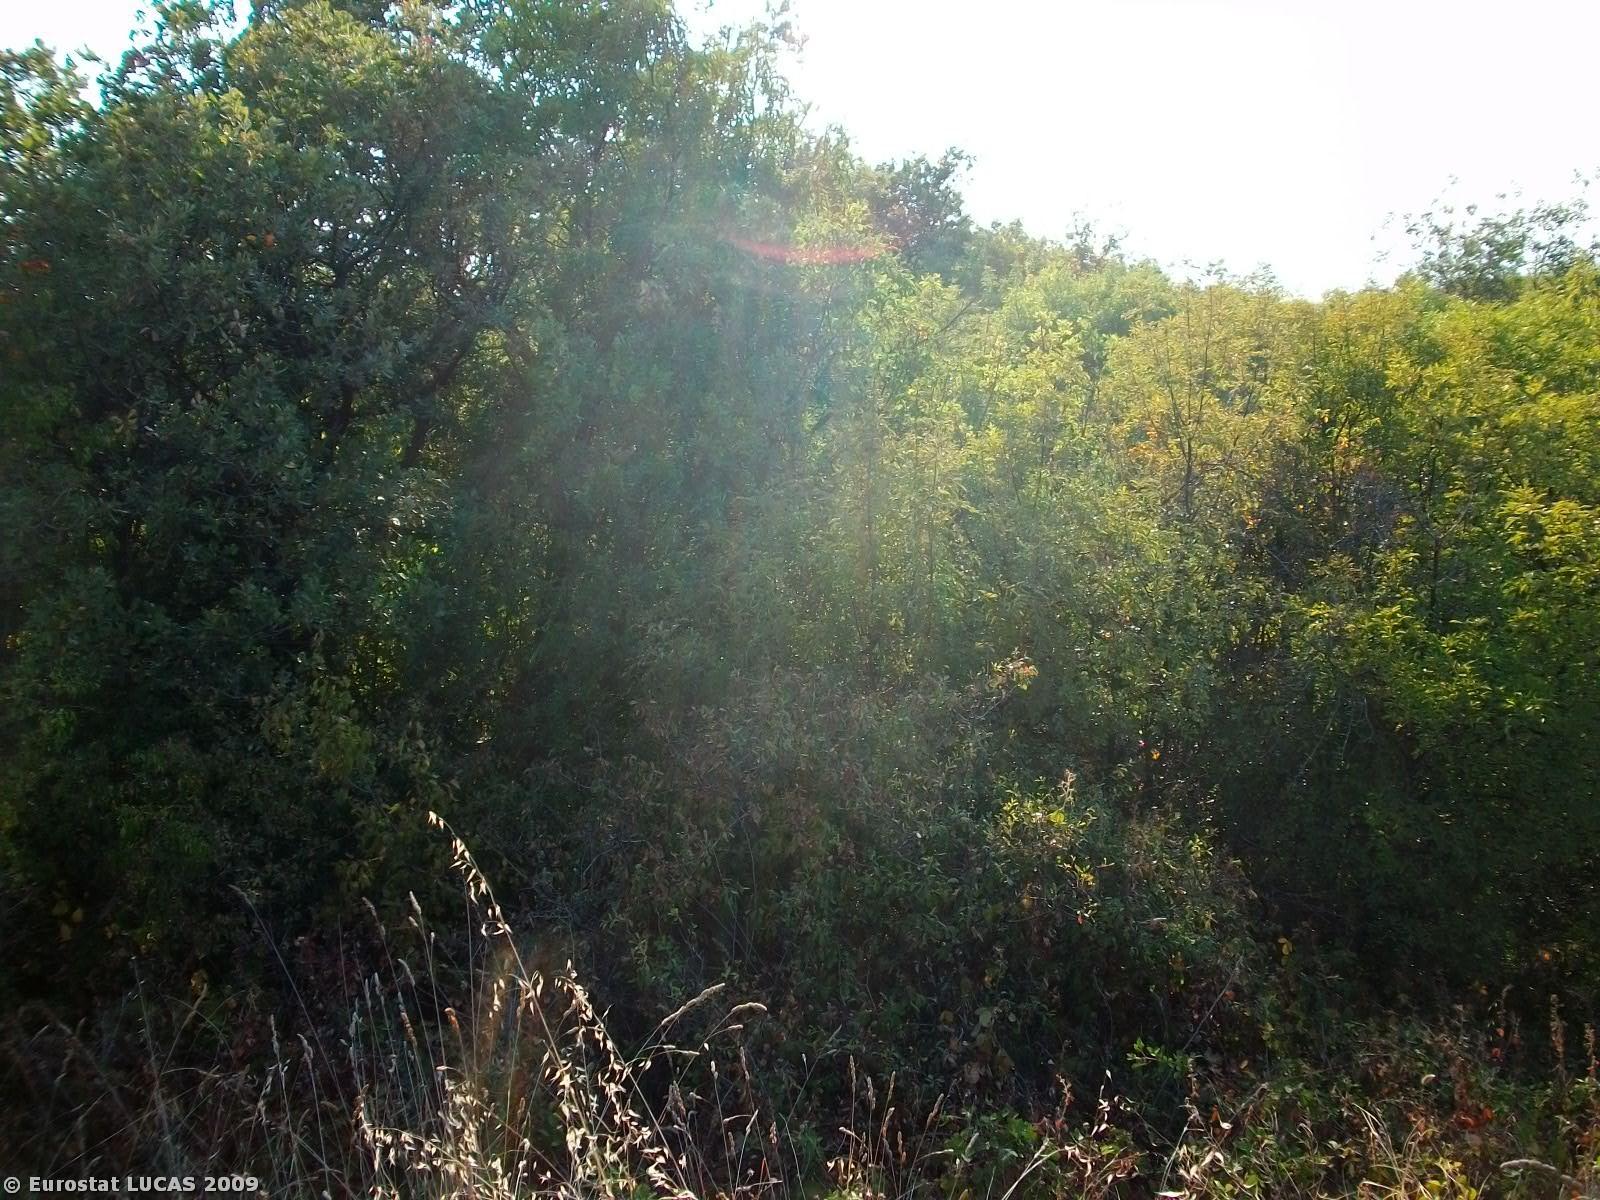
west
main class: Woodland
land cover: Broadleaved woodland
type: thermophilous deciduous forest
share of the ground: > 75 %
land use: Forestry
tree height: > 5 m
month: August
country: GR
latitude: 41.3240
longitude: 26.4059
